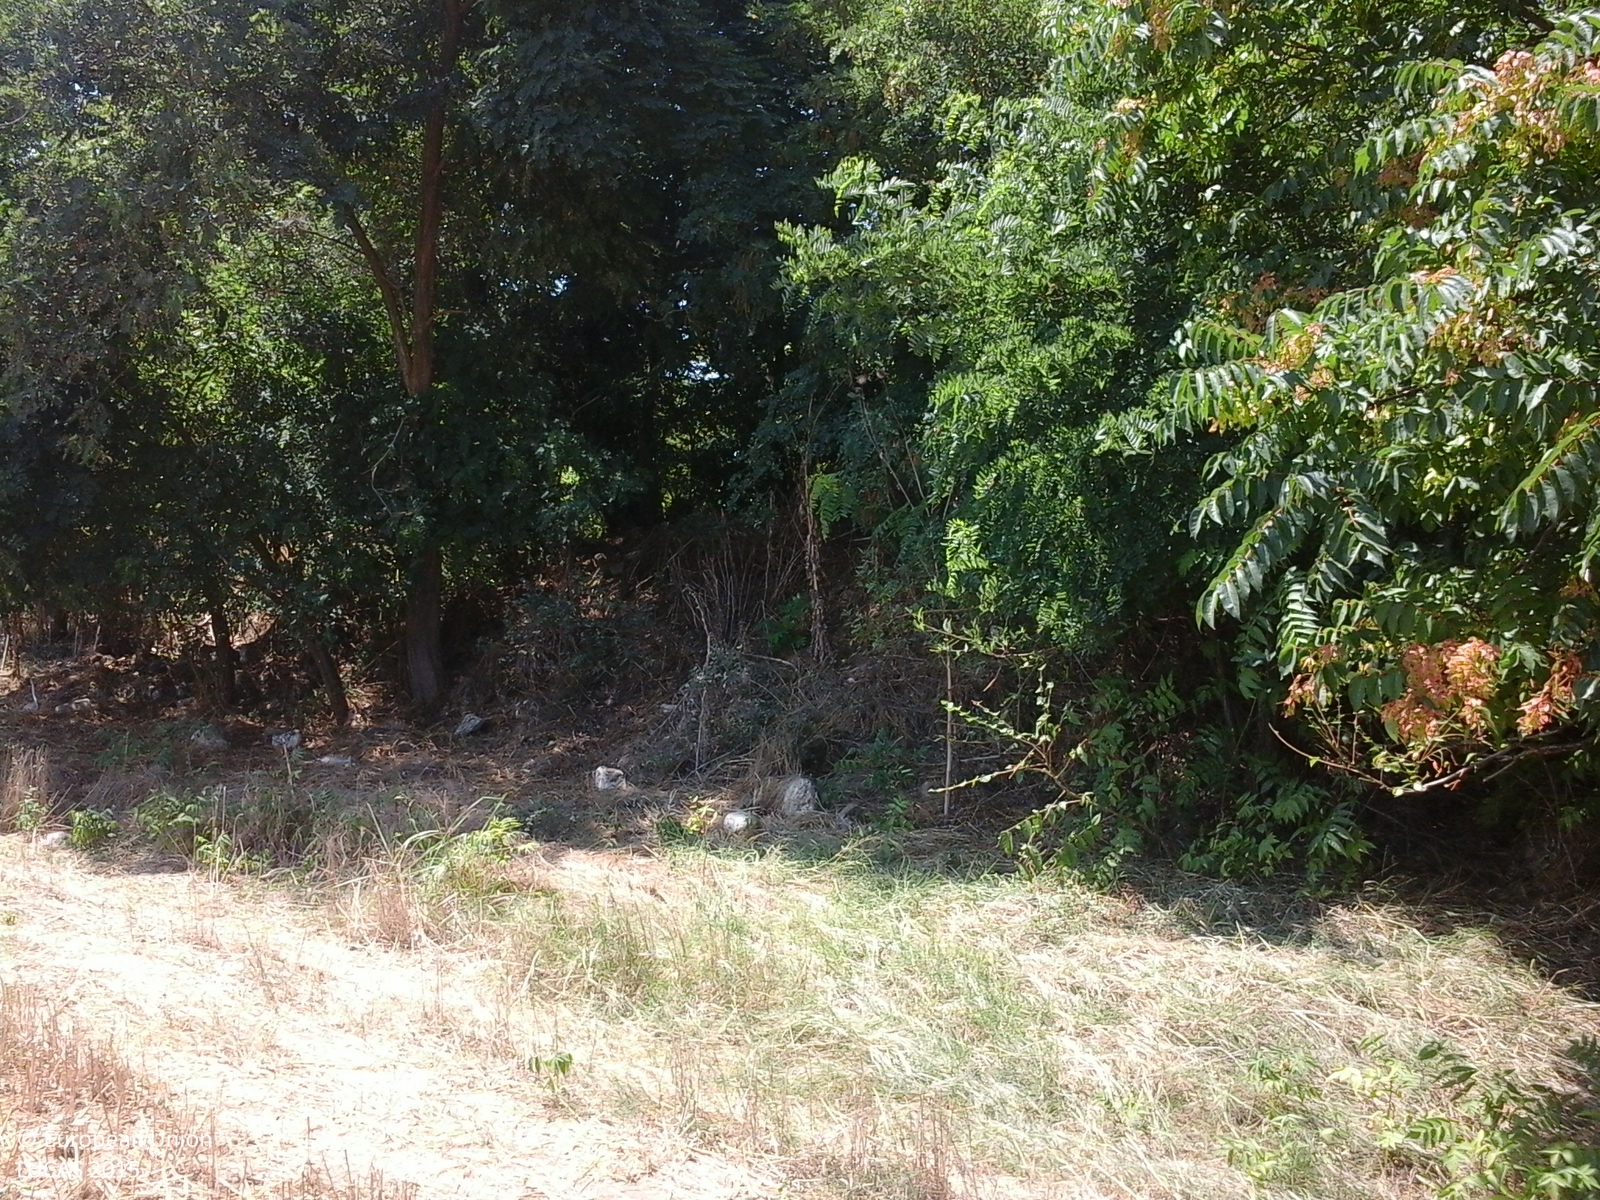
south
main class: Cropland
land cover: Common wheat
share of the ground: > 75 %
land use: Agriculture (excluding fallow land and kitchen gardens)
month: July
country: GR
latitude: 40.6527
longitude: 23.1971
